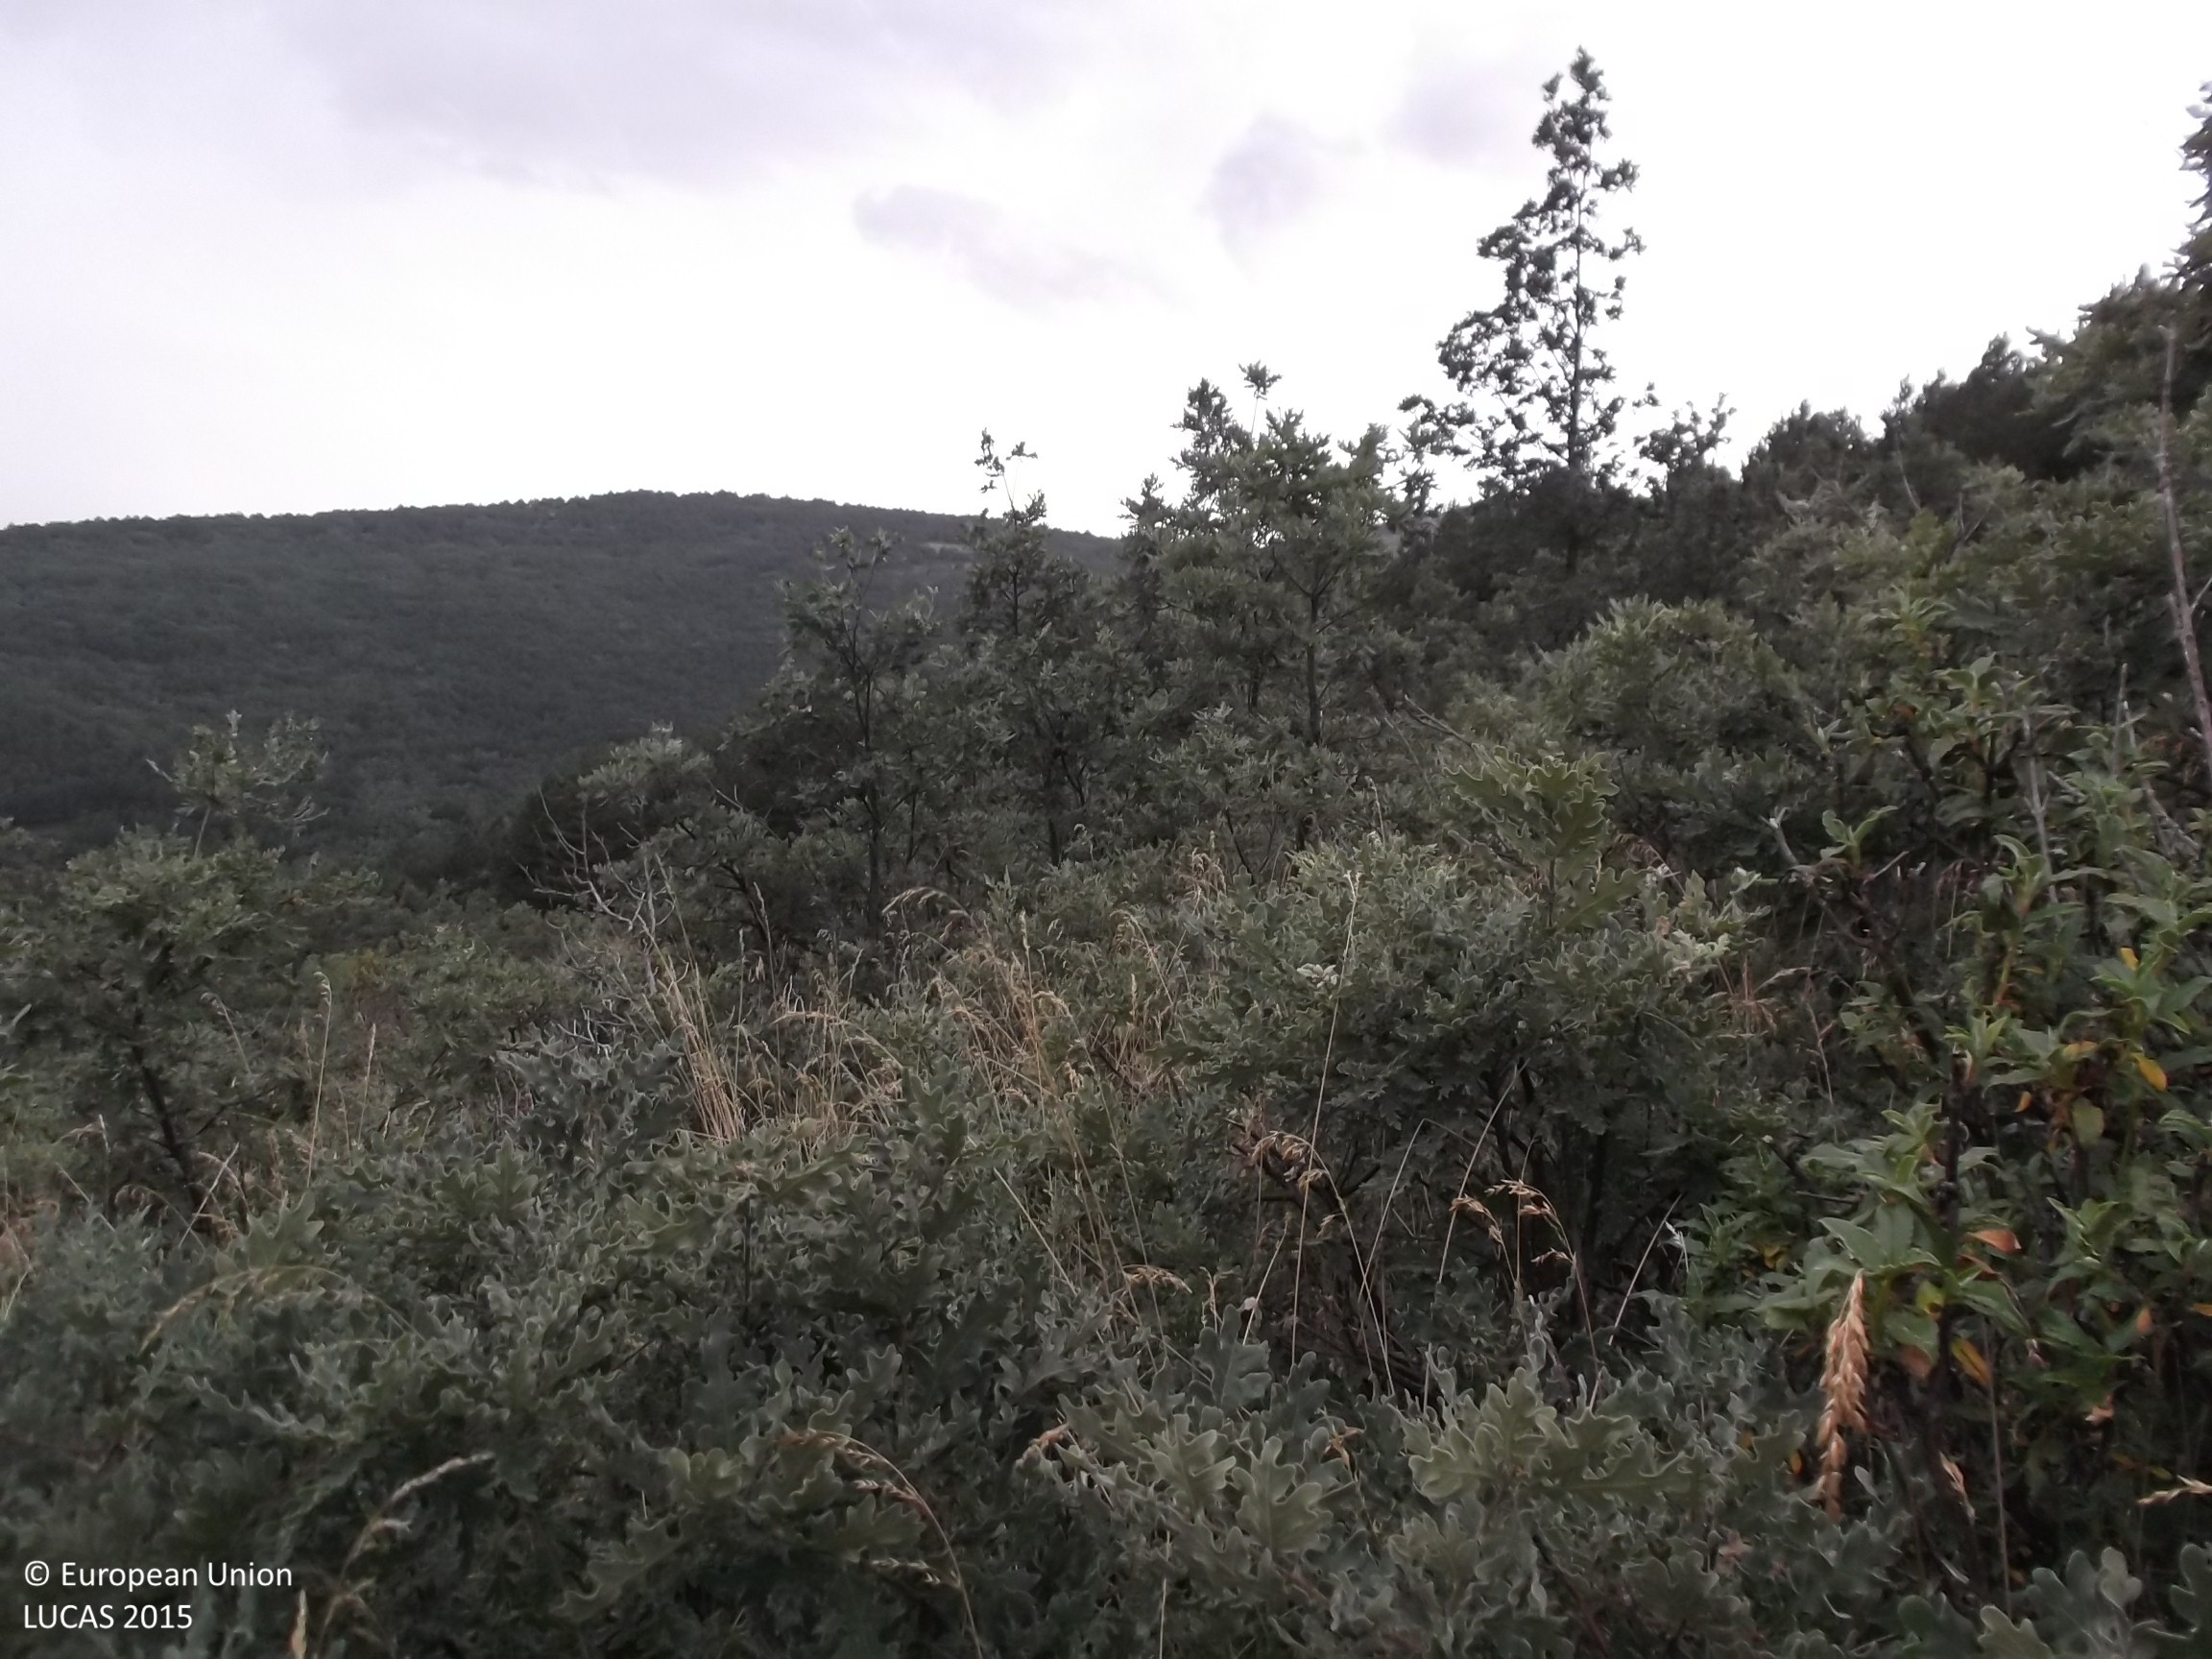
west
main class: Woodland
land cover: Broadleaved woodland
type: thermophilous deciduous forest
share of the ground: > 75 %
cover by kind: broadleaved forest trees 90 %, shrubs 10 %
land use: Forestry
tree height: > 5 m
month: July
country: ES
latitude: 42.0529
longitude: -2.2542
